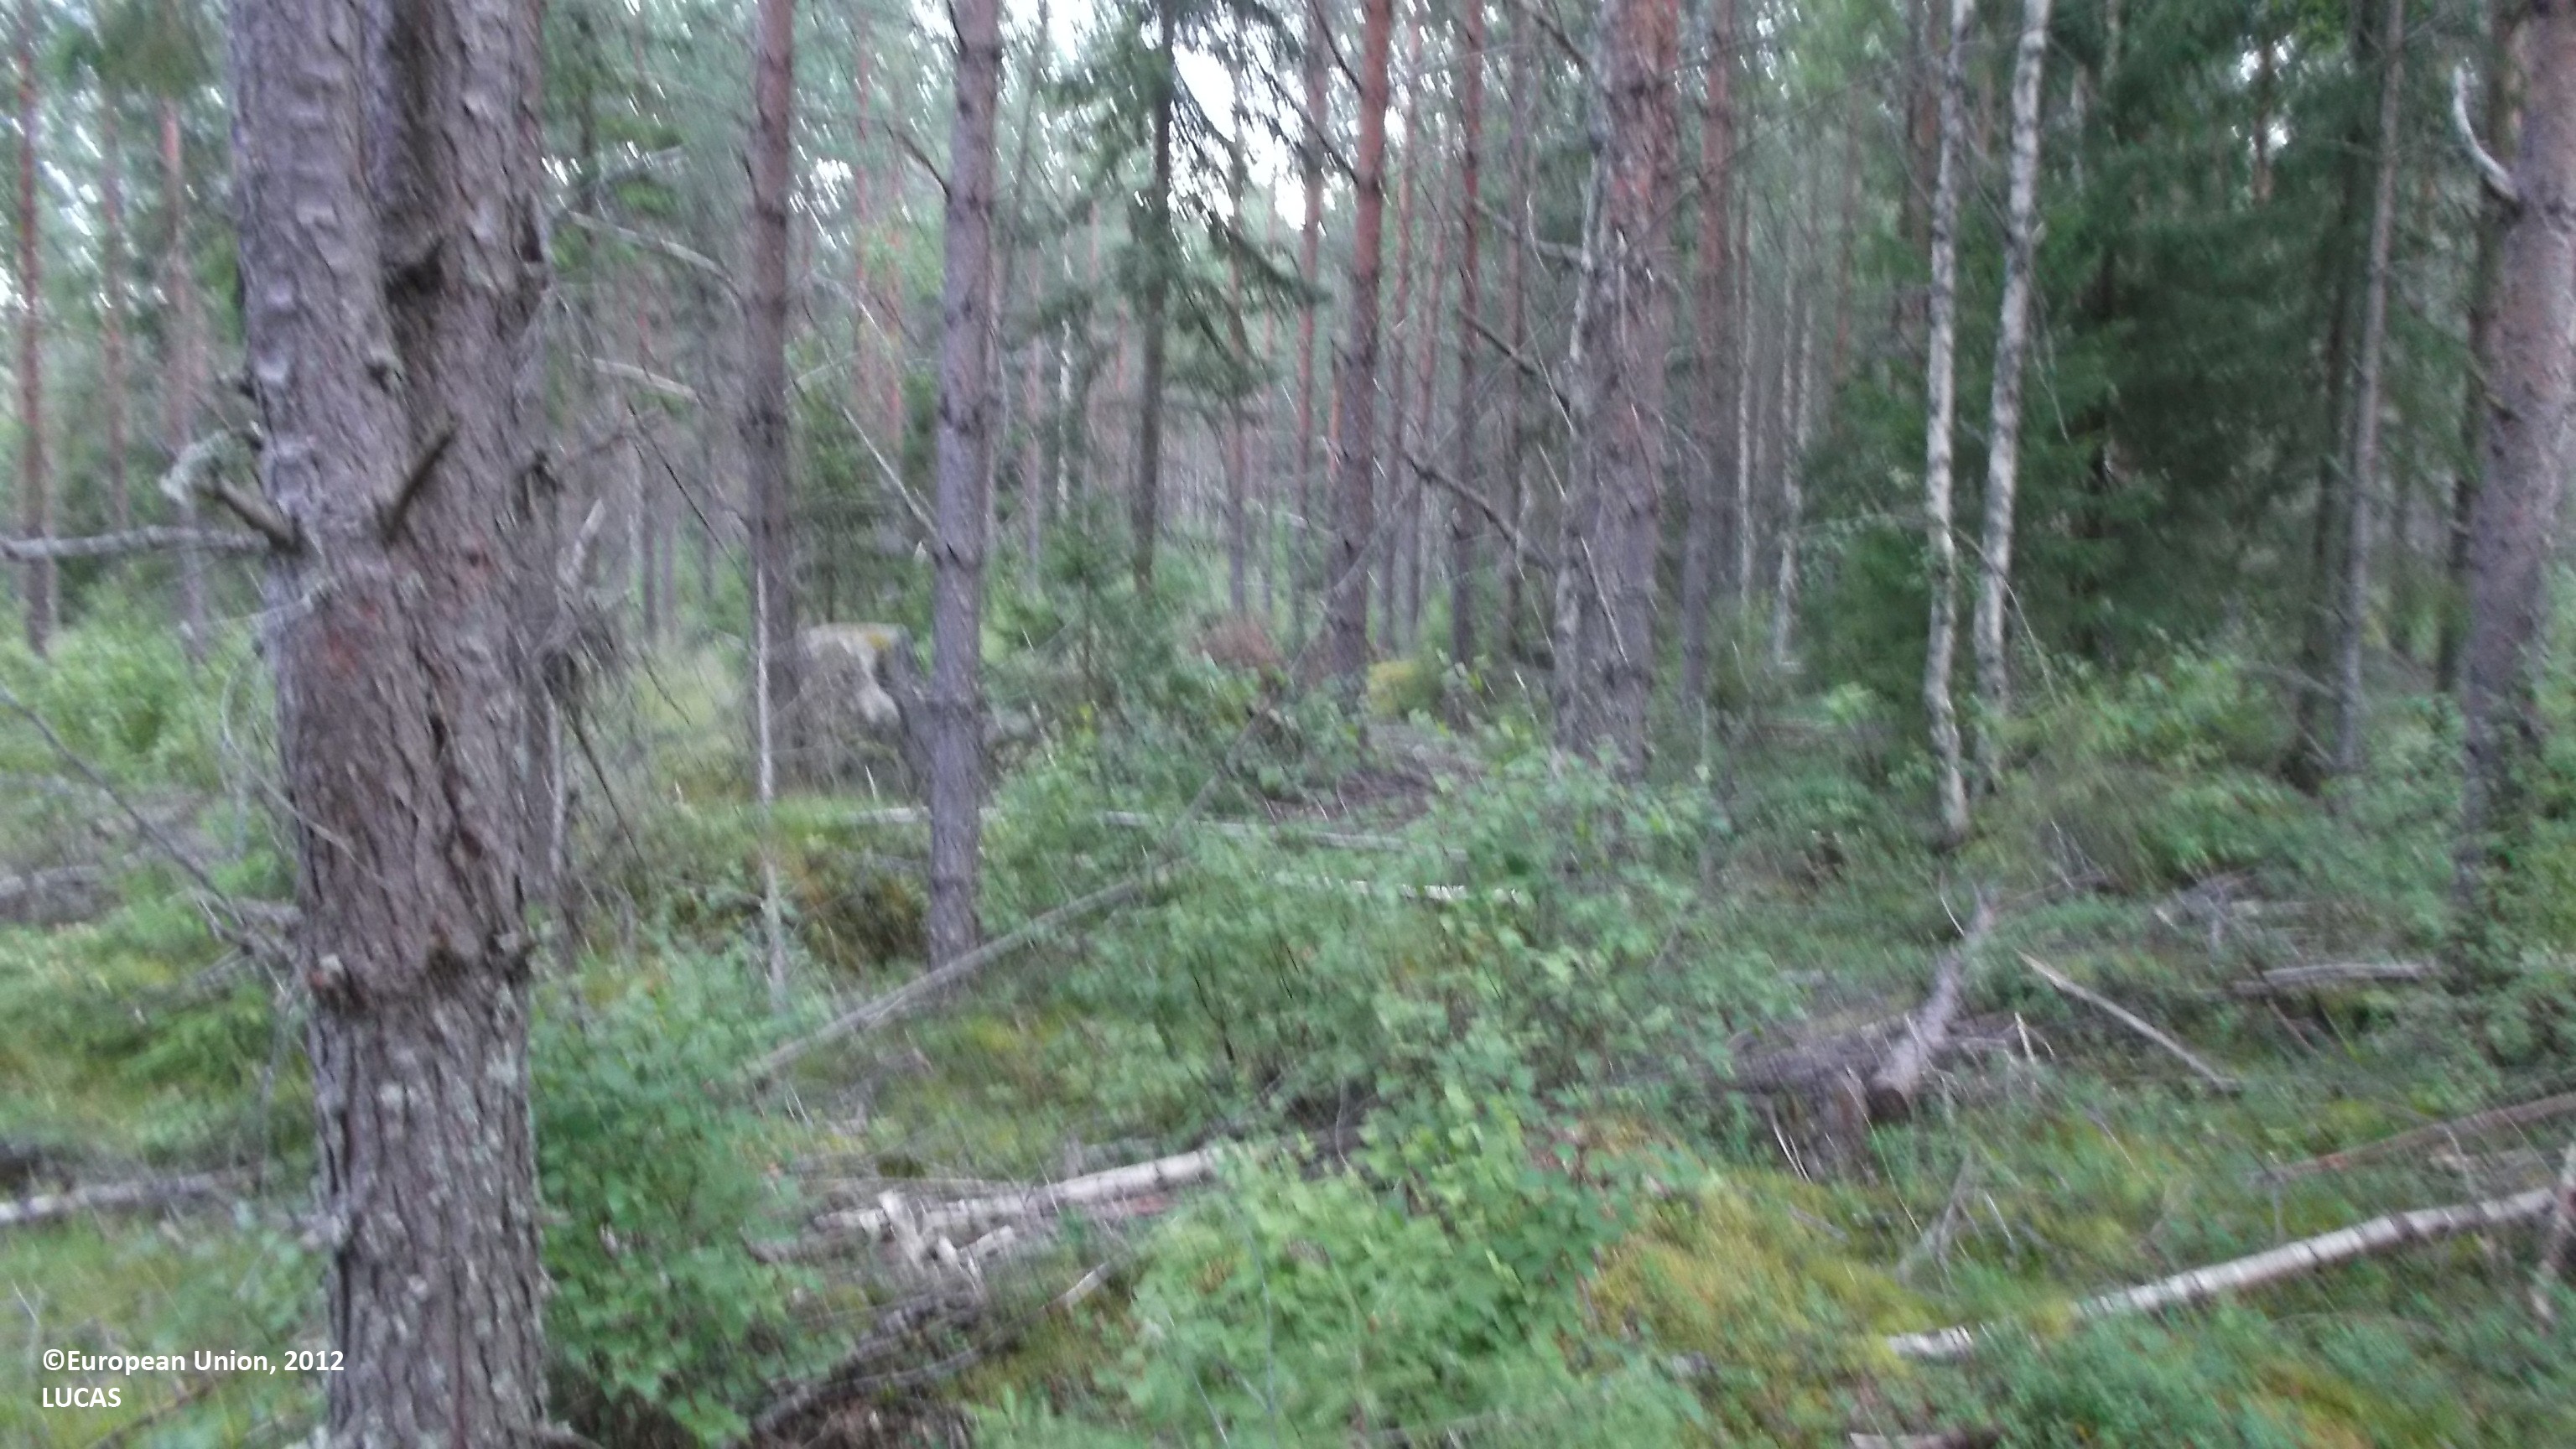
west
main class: Woodland
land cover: Pine dominated mixed woodland
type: boreal forest
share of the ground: 50 - 75 %
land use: Forestry
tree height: > 5 m
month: July
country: FI
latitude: 63.6143
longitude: 23.3084
